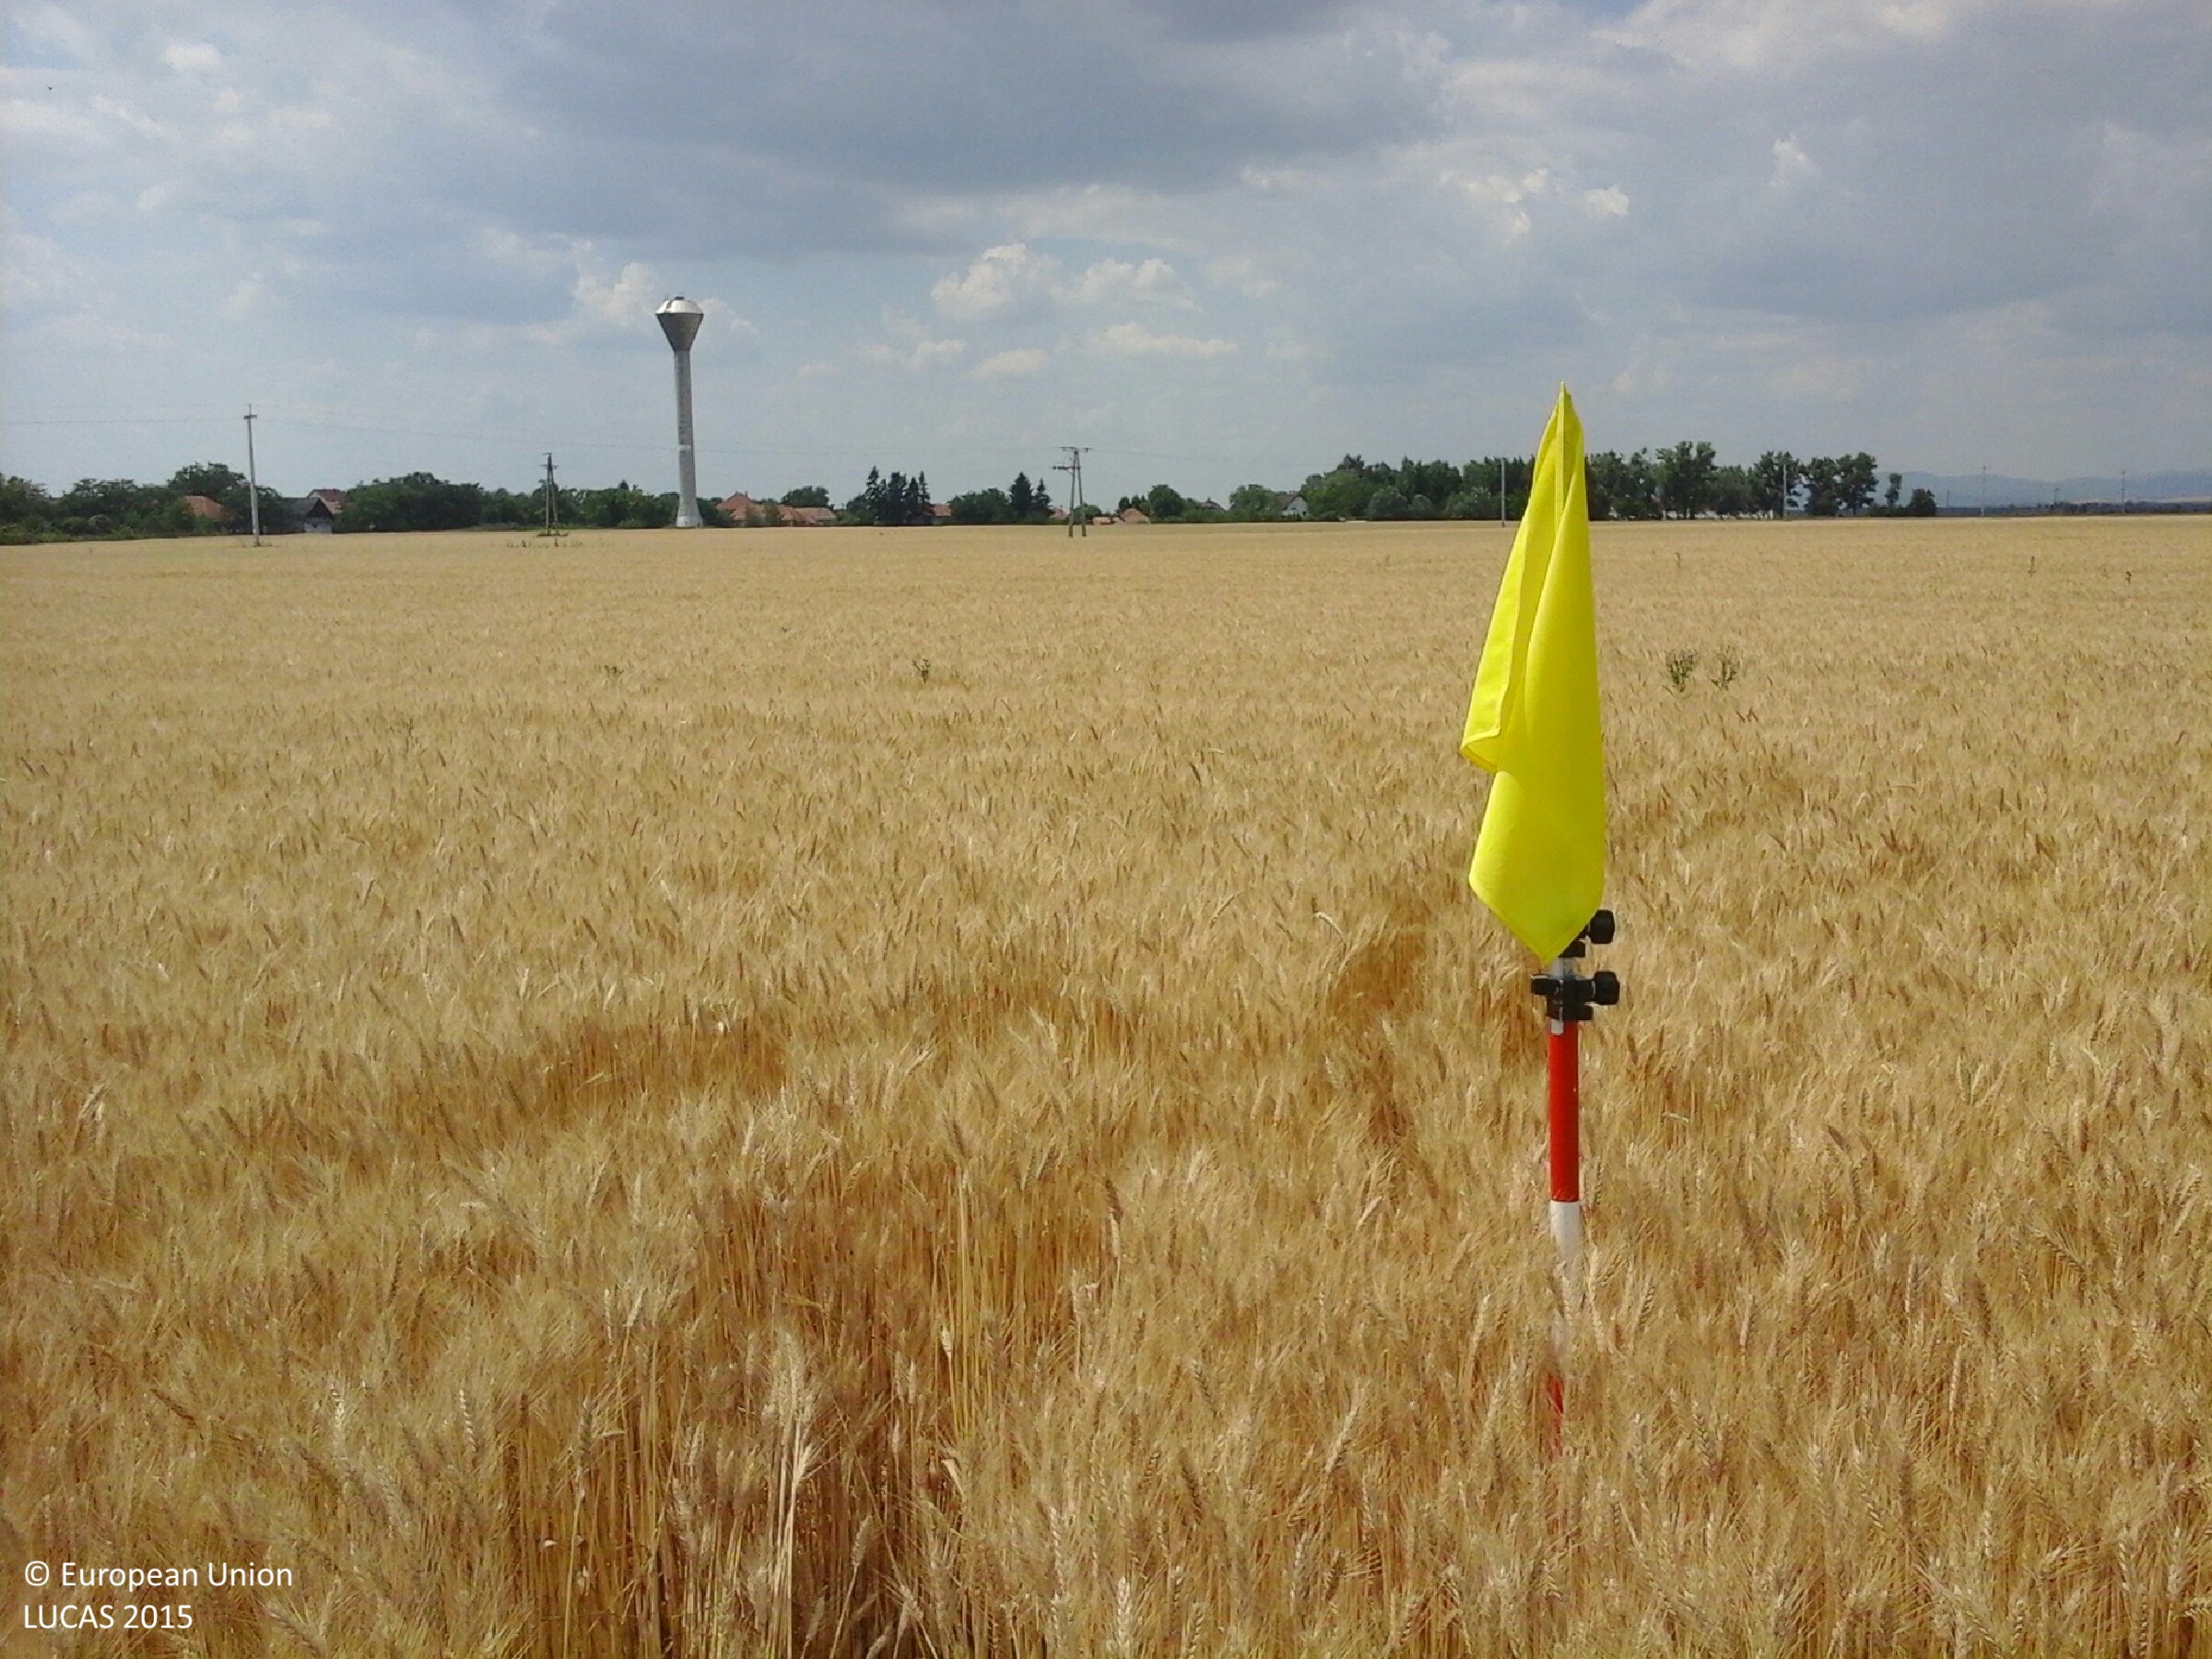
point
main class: Cropland
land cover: Common wheat
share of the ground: > 75 %
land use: Agriculture (excluding fallow land and kitchen gardens)
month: July
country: HU
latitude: 47.7767
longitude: 20.6703
